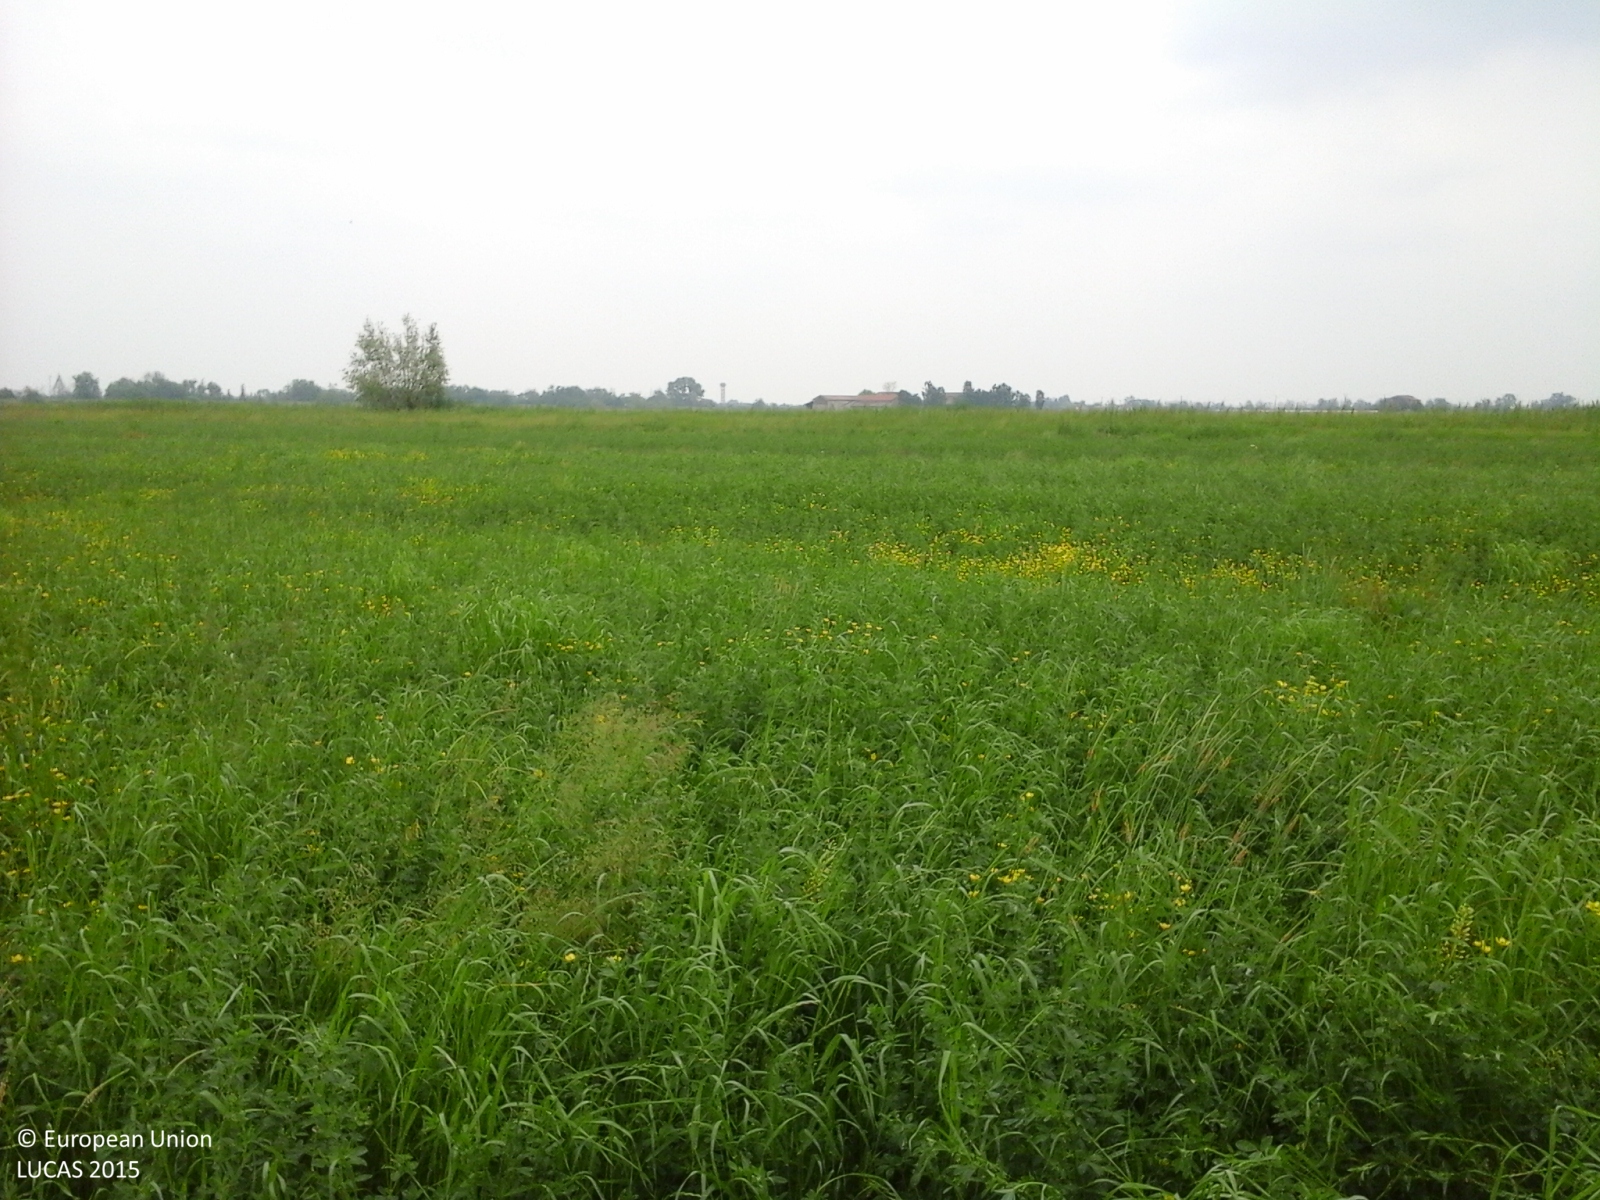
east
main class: Cropland
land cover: Lucerne
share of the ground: > 75 %
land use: Agriculture (excluding fallow land and kitchen gardens)
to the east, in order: Lucerne; Ditches and canals; Lucerne; Ditches and canals; Lucerne; Inland fresh running water; Single bushes/trees; Grass margins; Tracks; Grass margins; Inland fresh running water; Tracks; Grass margins; Spontaneously vegetated surfaces; Ditches and canals; Spontaneously vegetated surfaces
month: May
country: IT
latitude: 44.8889
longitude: 10.7455
